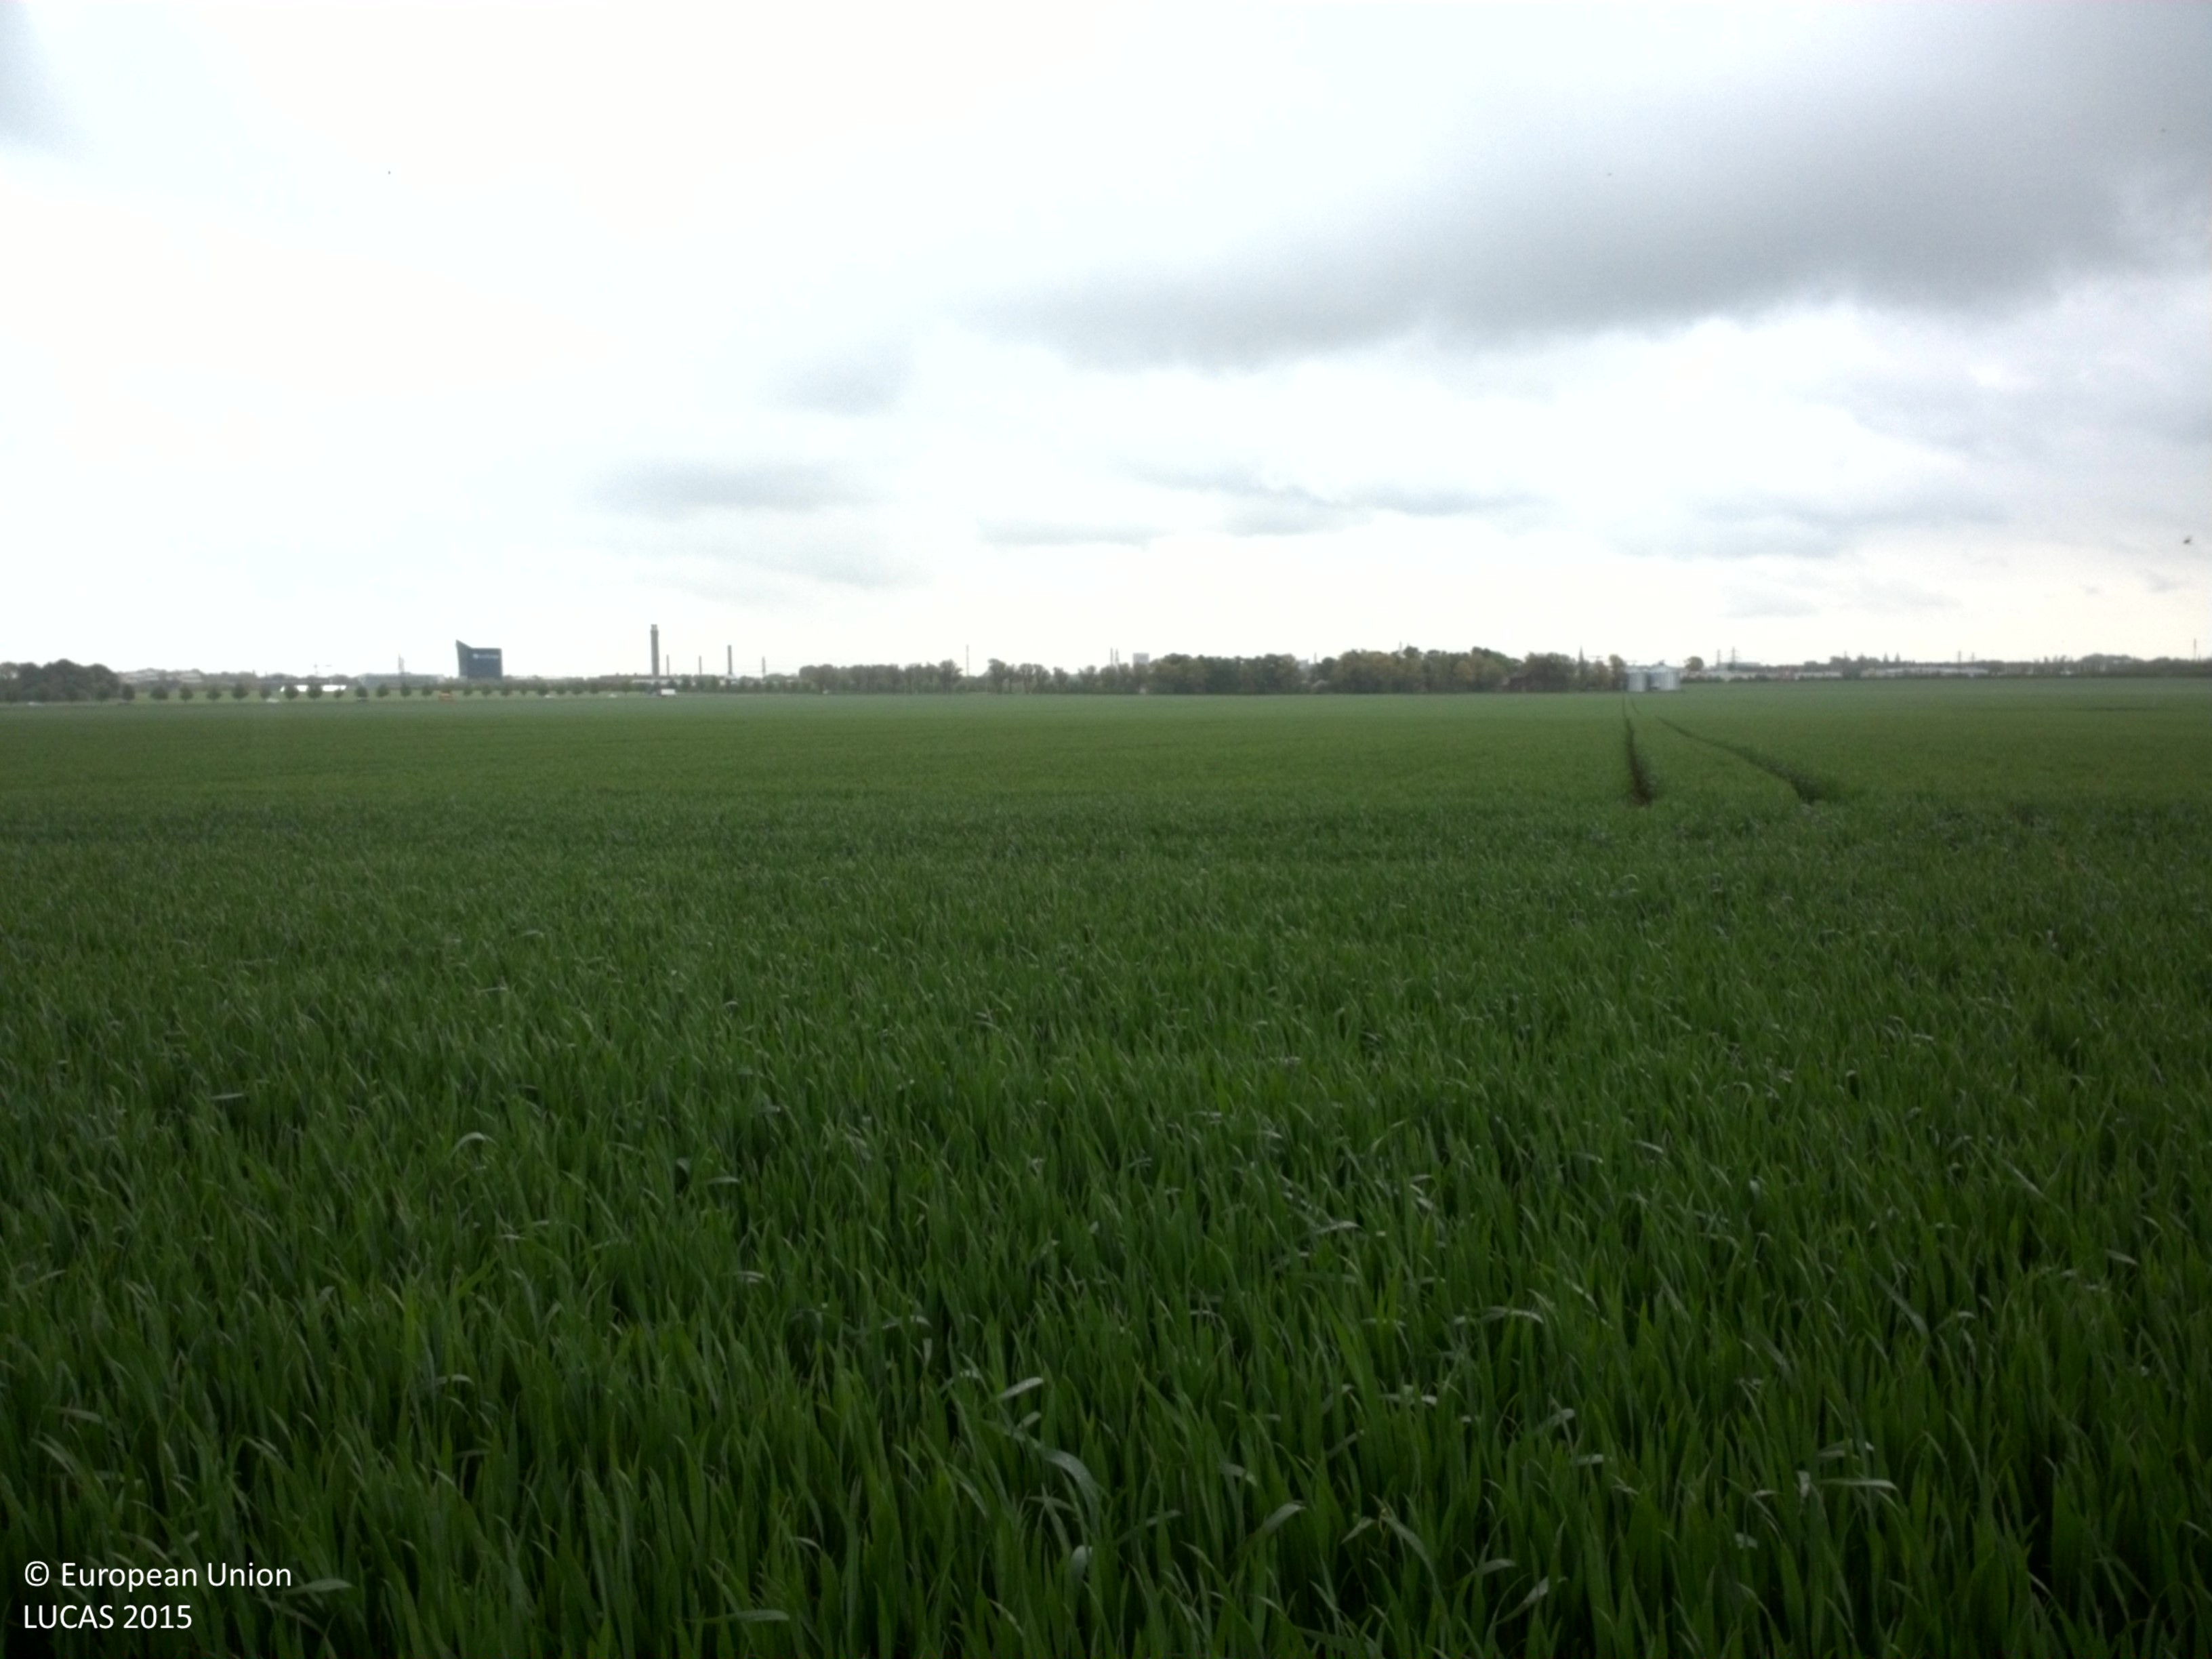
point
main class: Cropland
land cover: Common wheat
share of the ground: > 75 %
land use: Agriculture (excluding fallow land and kitchen gardens)
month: May
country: SE
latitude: 55.7178
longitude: 13.1339
